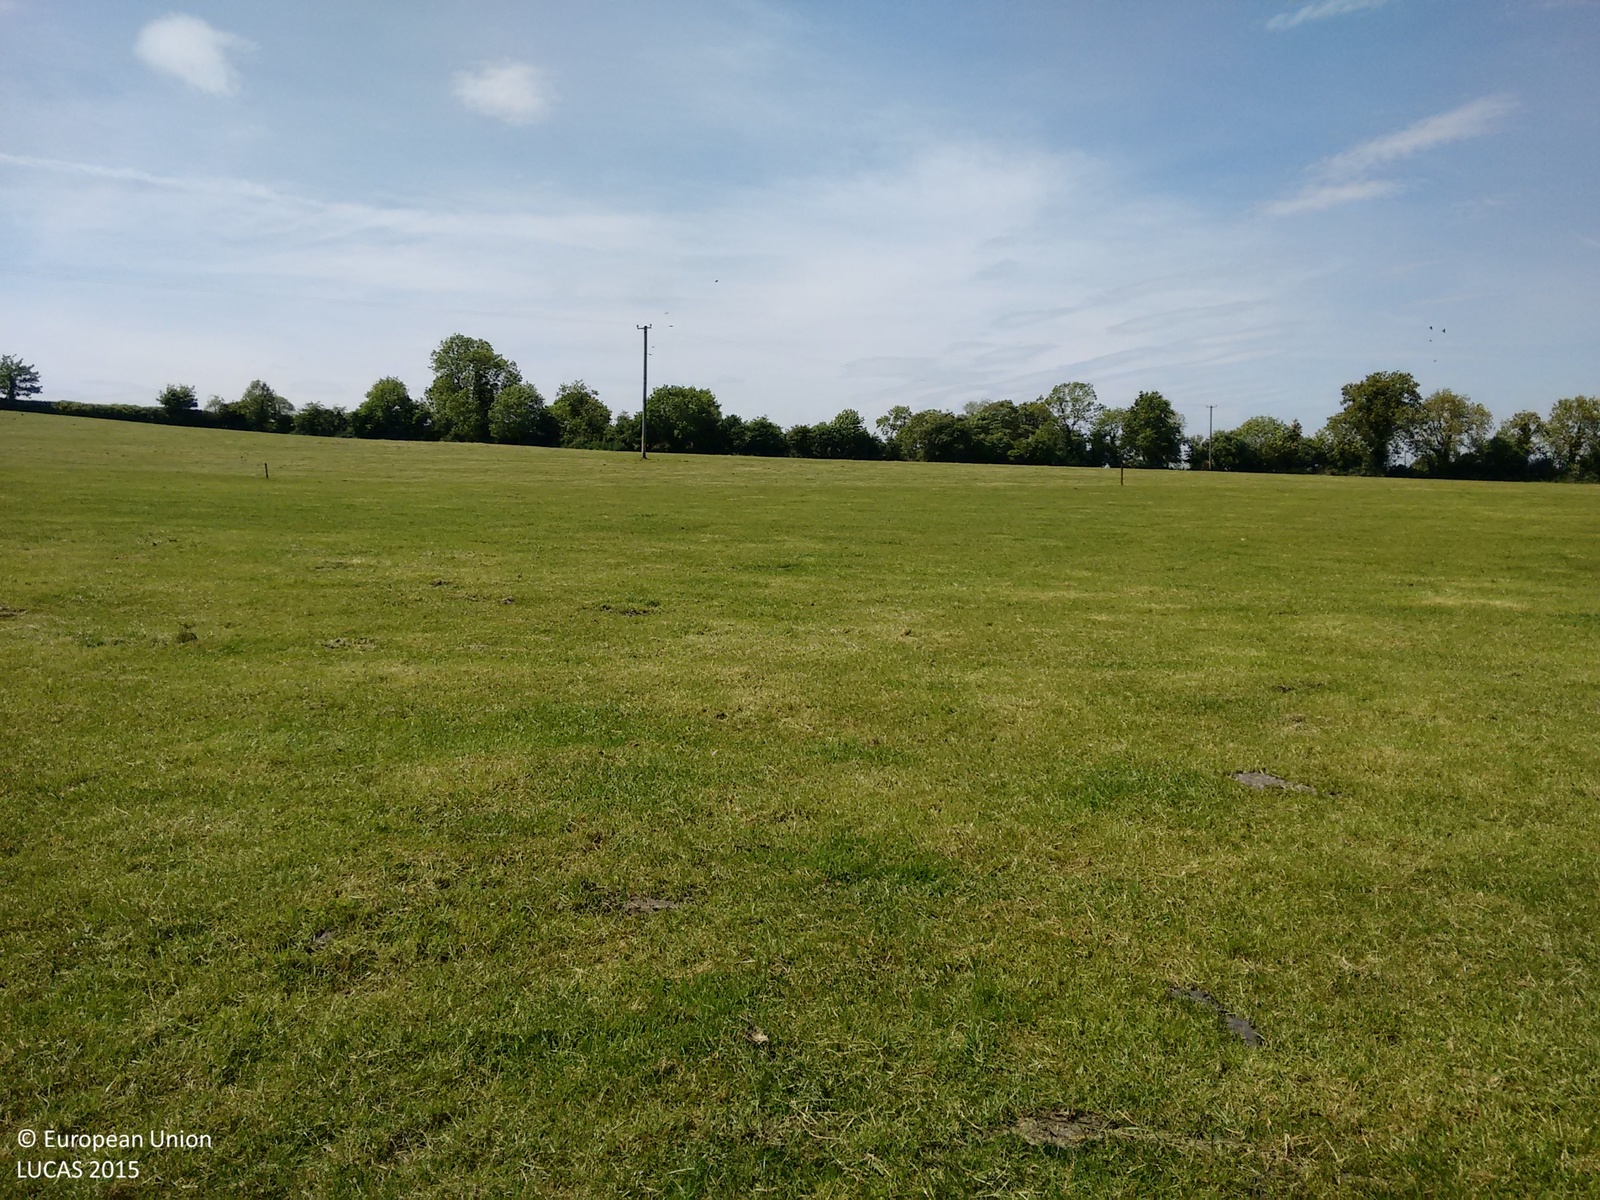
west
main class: Grassland
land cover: Grassland without tree/shrub cover
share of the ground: > 75 %
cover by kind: herbaceous plants 90 %, unconsolidated bare surface 10 %
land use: Agriculture (excluding fallow land and kitchen gardens)
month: June
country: IE
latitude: 53.5850
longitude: -6.6101
